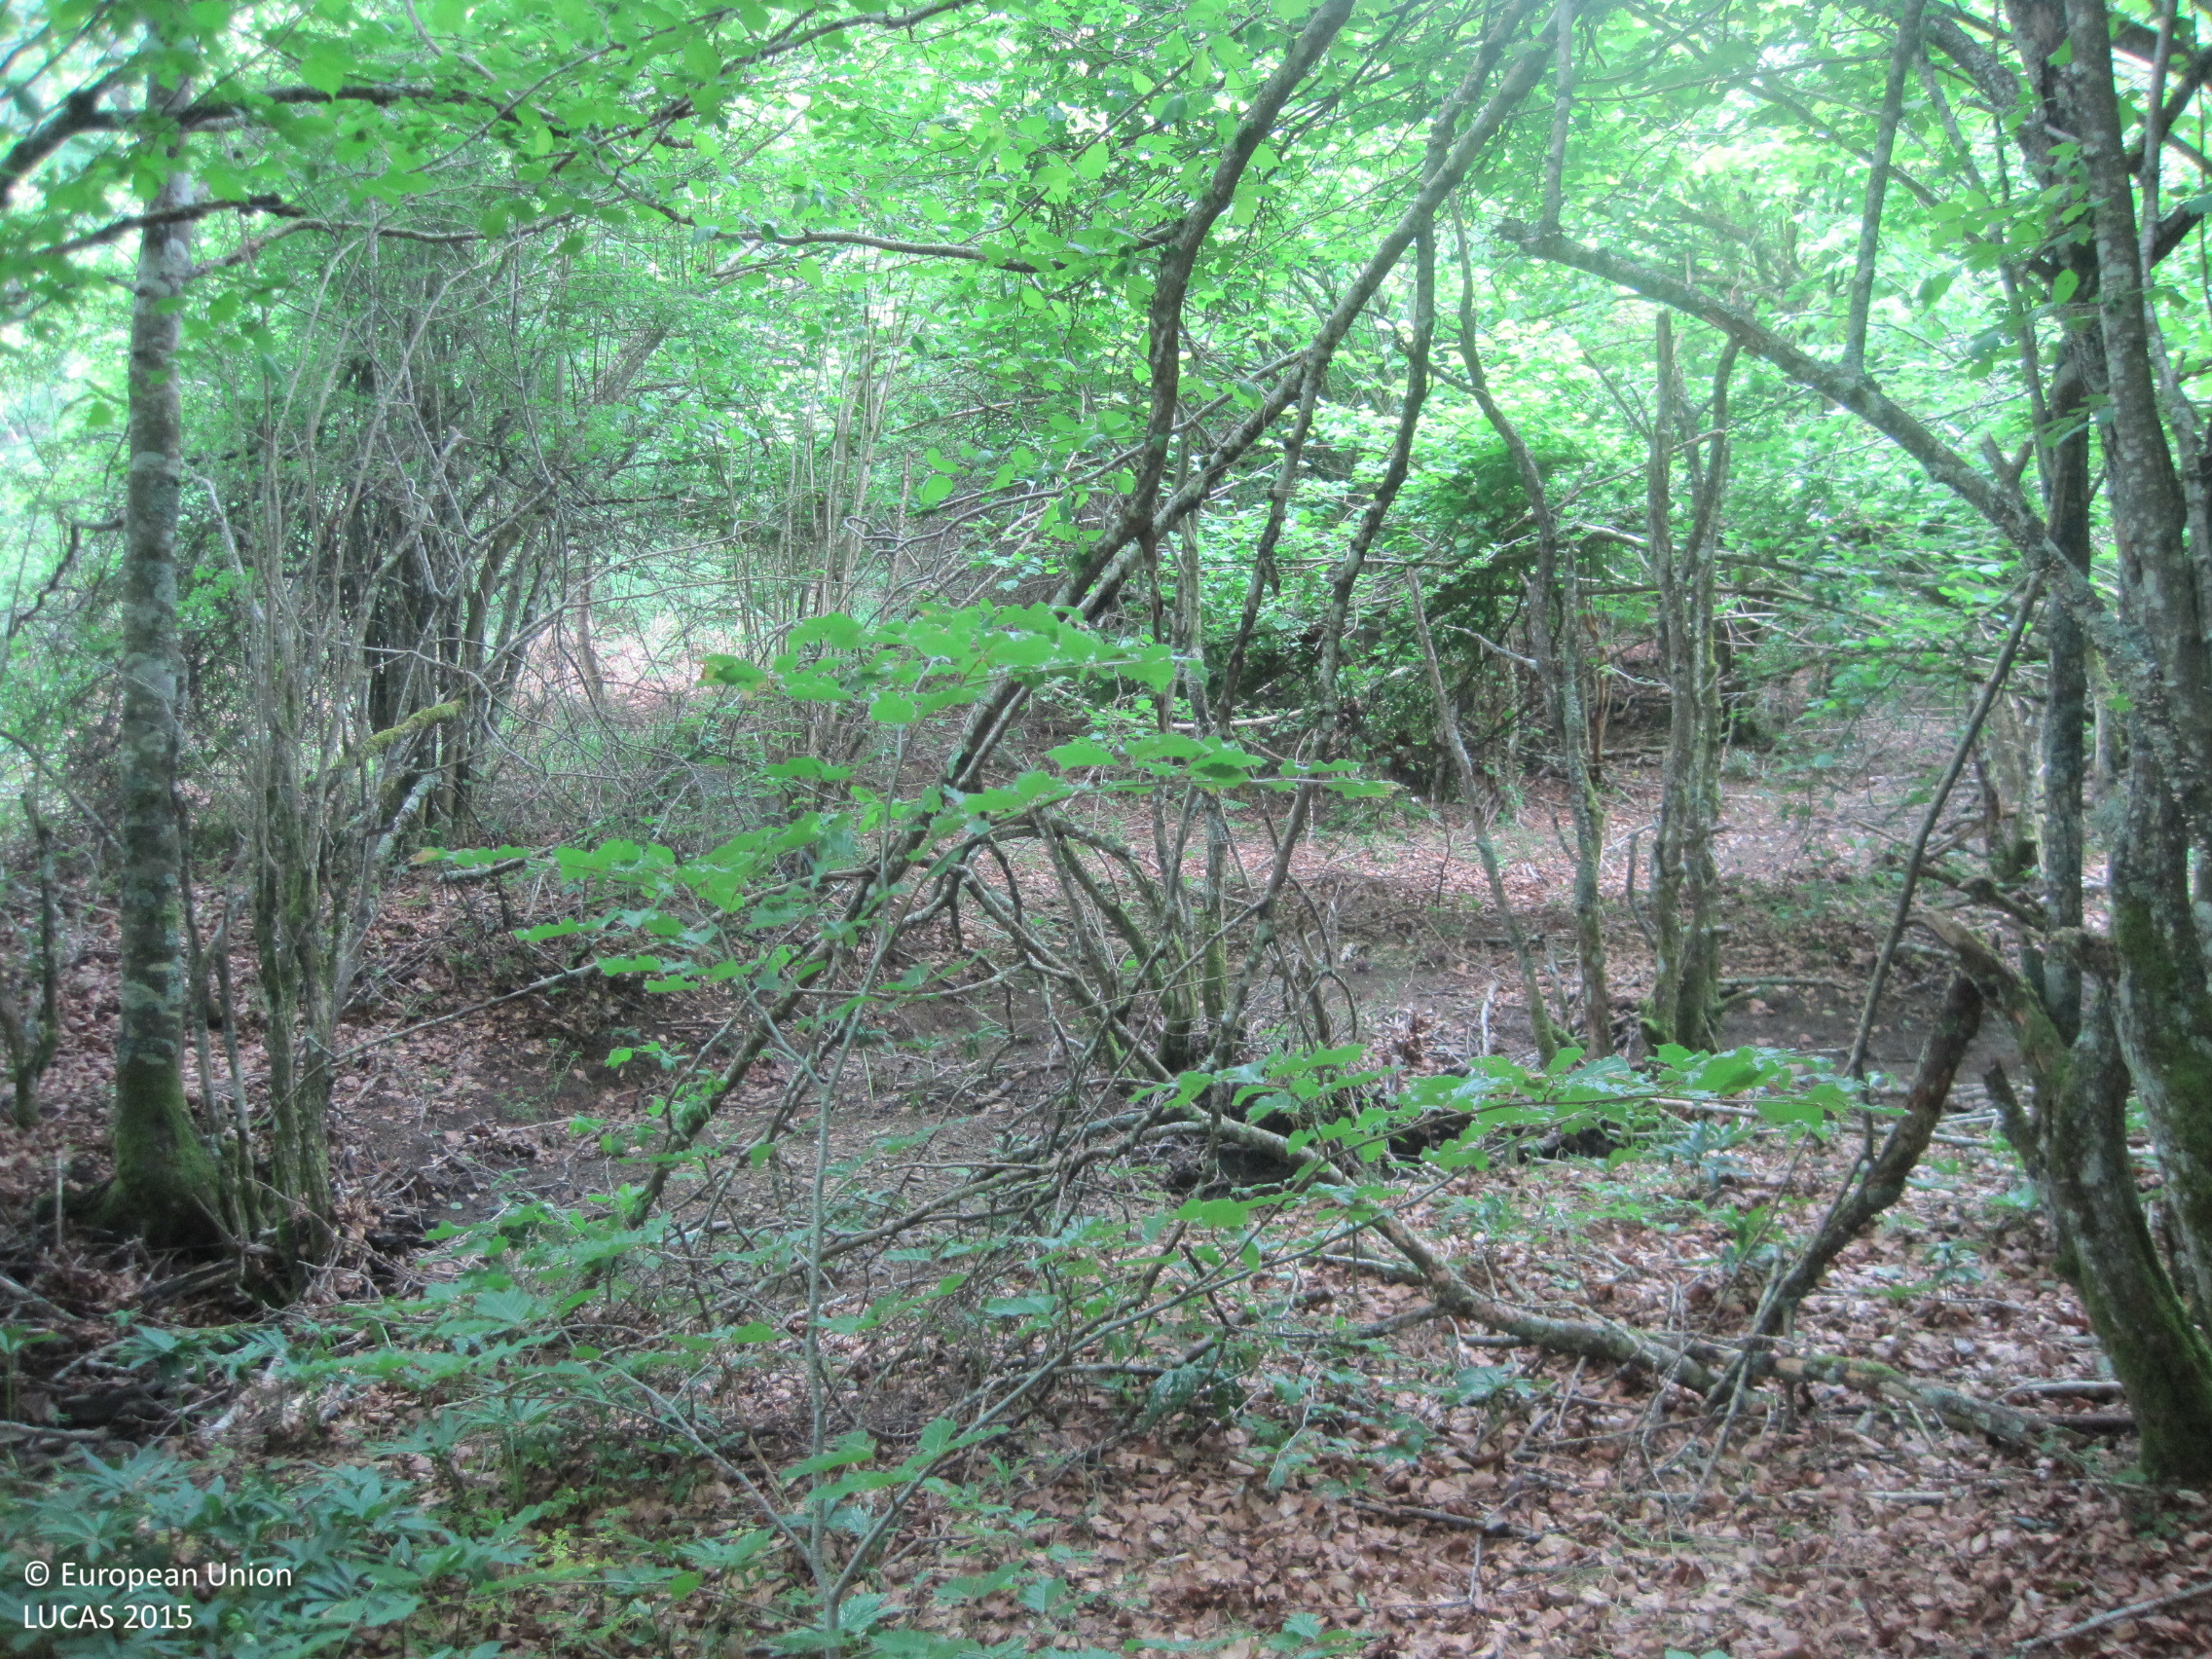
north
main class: Woodland
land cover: Broadleaved woodland
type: beech forest
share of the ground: > 75 %
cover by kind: broadleaved forest trees 100 %
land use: Forestry
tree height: > 5 m
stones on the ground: < 10 %
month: May
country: ES
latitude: 43.0019
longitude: -1.3108
